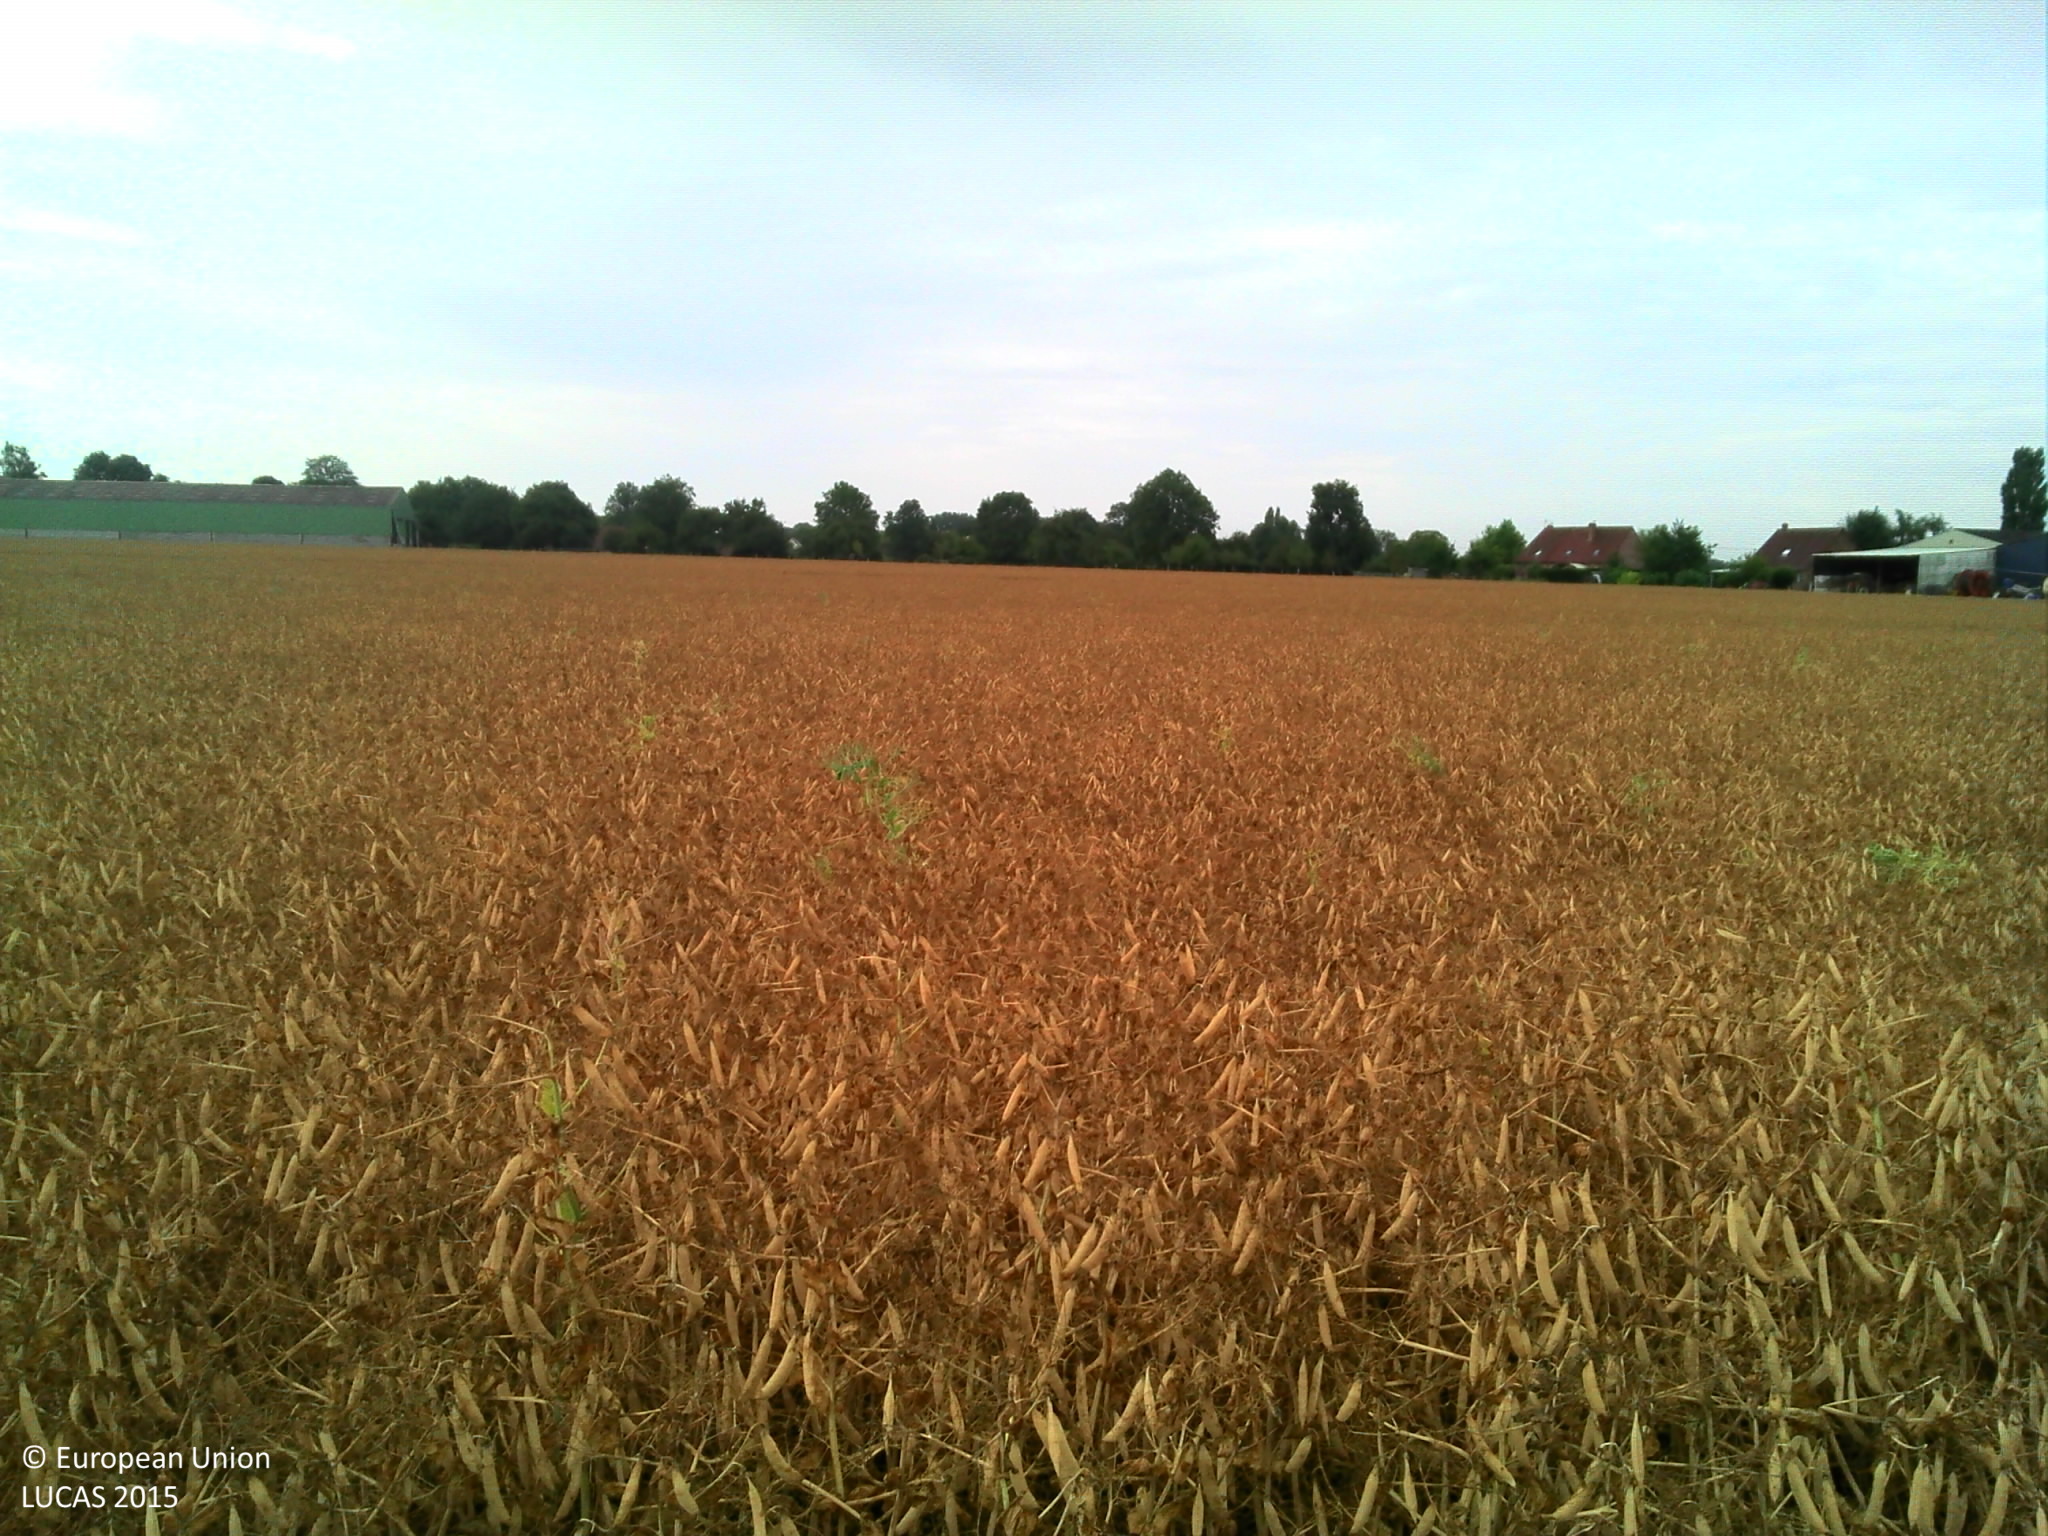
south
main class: Cropland
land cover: Dry pulses
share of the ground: > 75 %
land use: Agriculture (excluding fallow land and kitchen gardens)
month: July
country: FR
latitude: 50.0241
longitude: 2.1831
